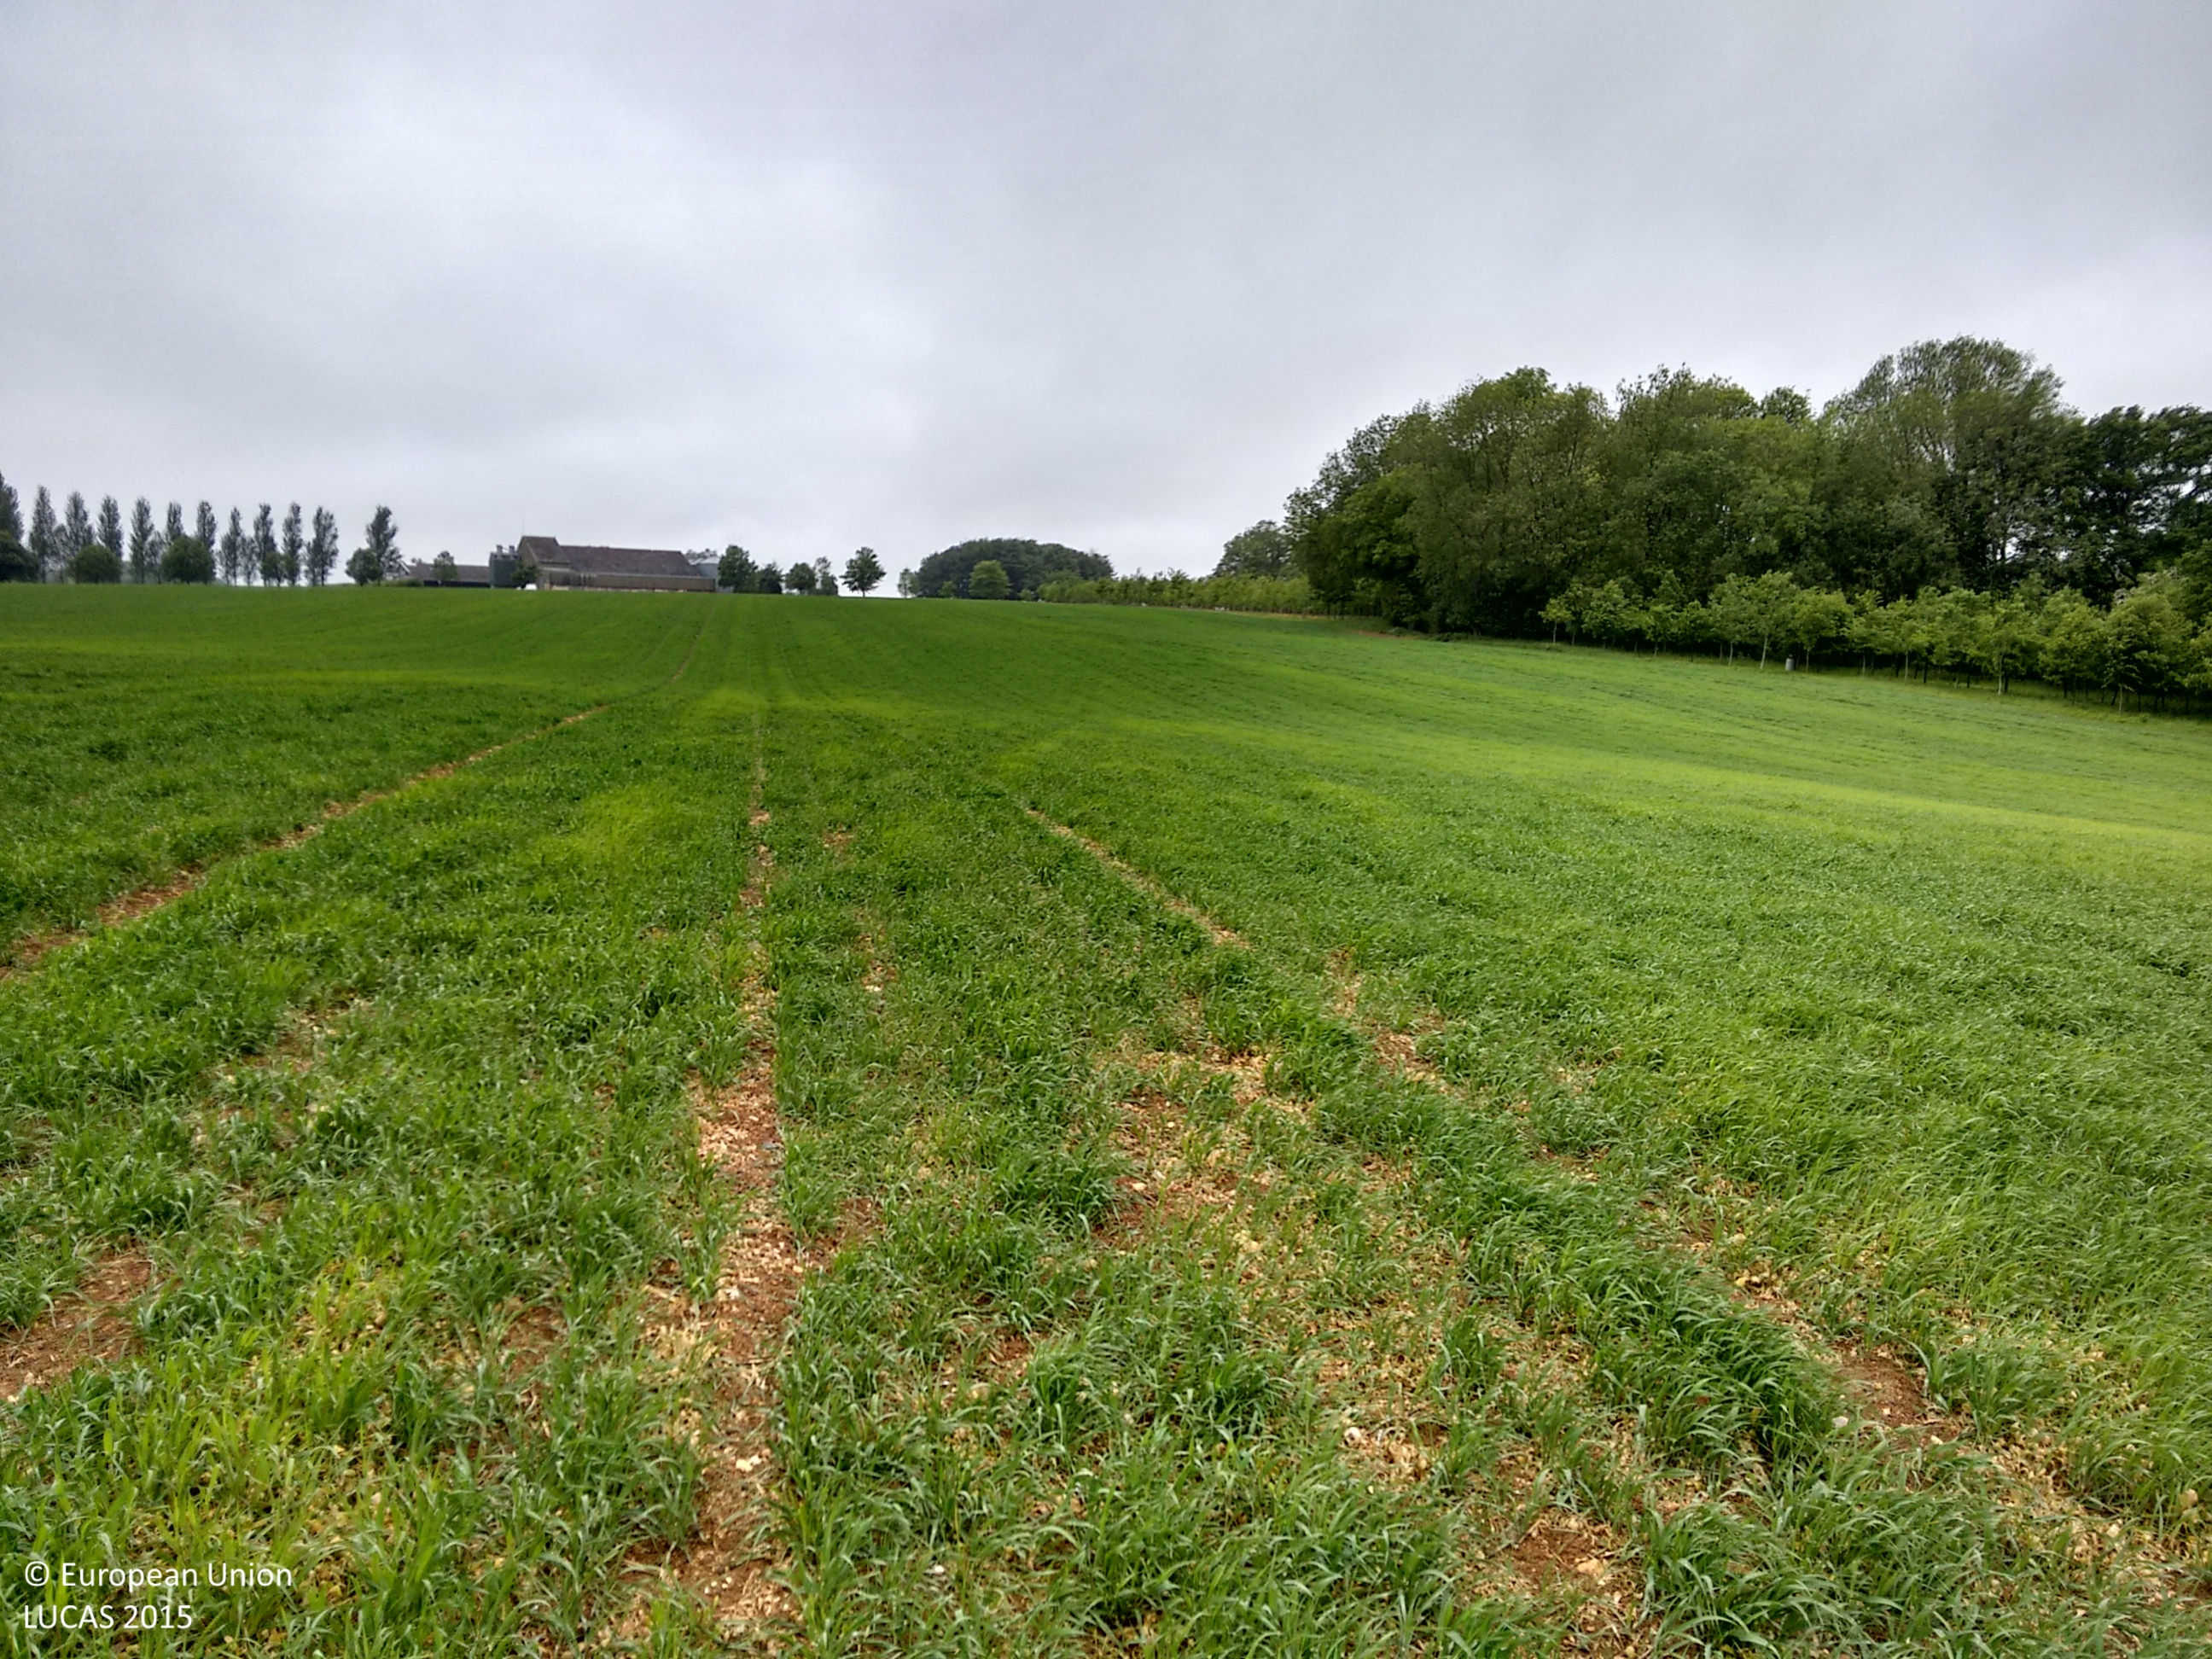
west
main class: Cropland
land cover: Barley
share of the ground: 50 - 75 %
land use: Agriculture (excluding fallow land and kitchen gardens)
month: June
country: GB
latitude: 51.1803
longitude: -1.1328
